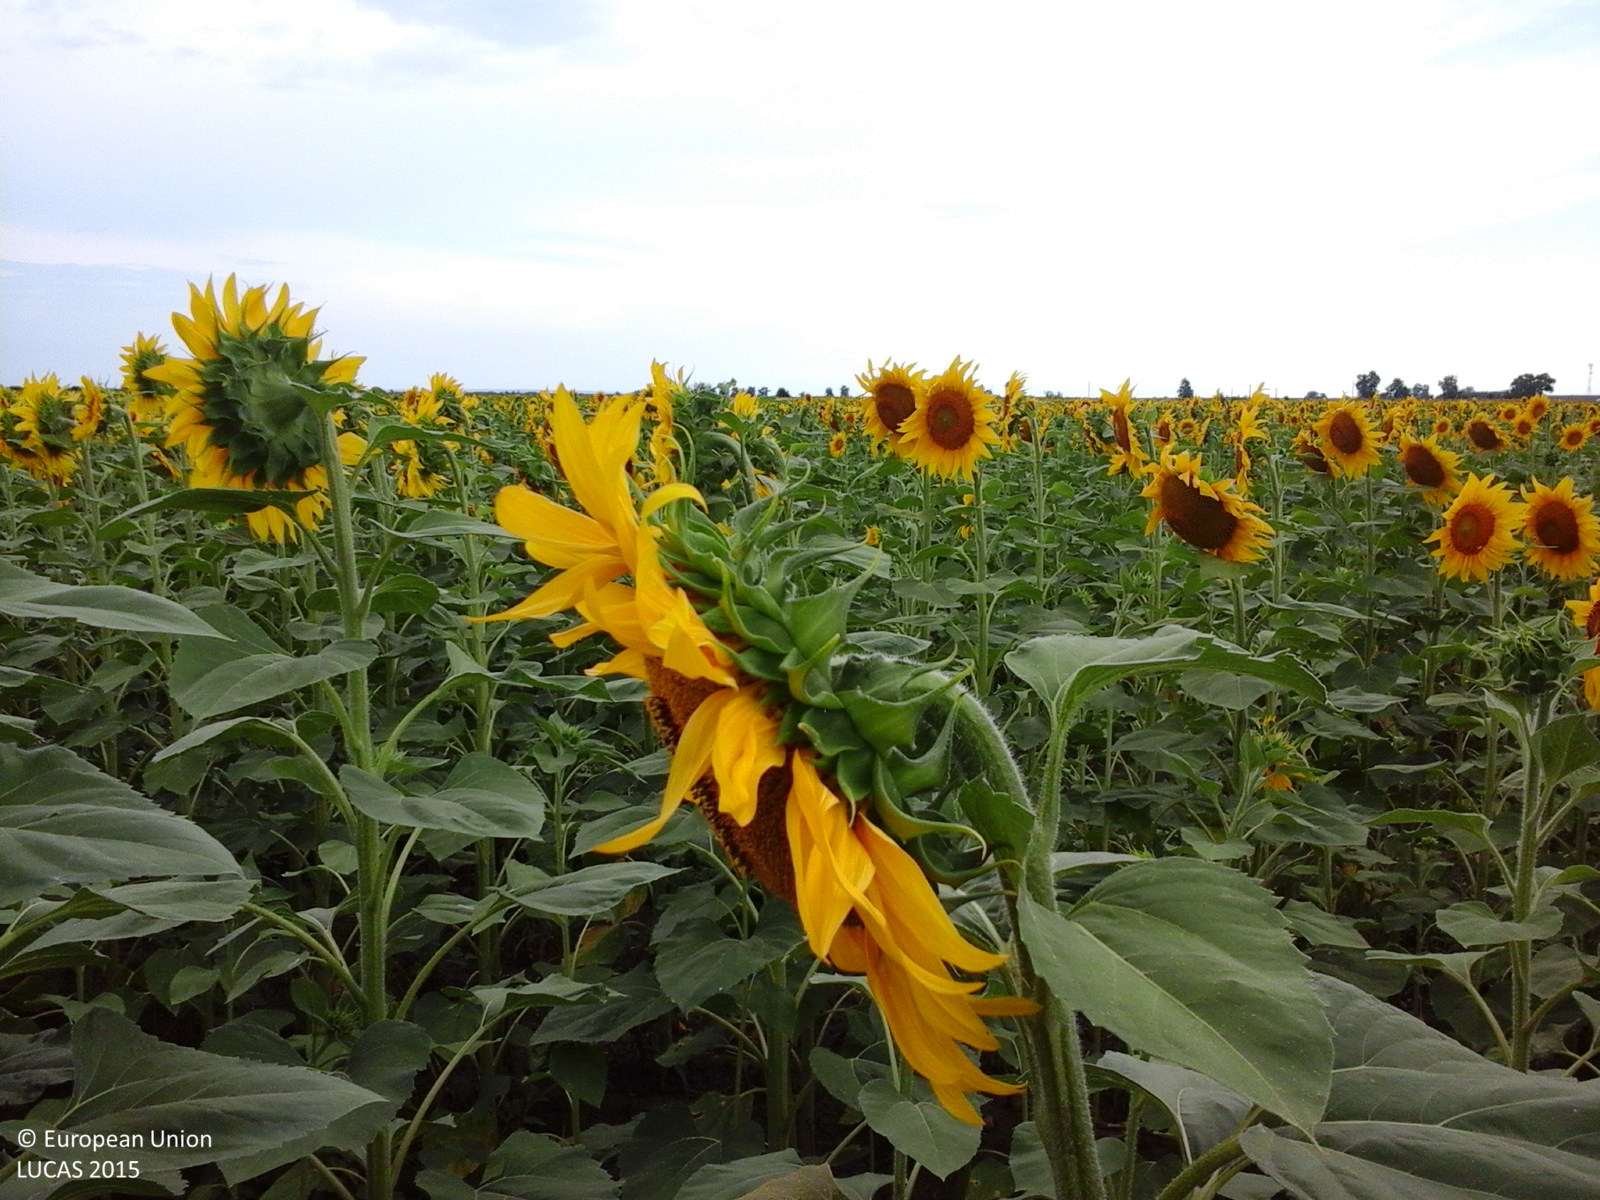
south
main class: Cropland
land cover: Sunflower
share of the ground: > 75 %
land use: Agriculture (excluding fallow land and kitchen gardens)
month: July
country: RO
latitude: 43.9010
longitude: 24.4445
